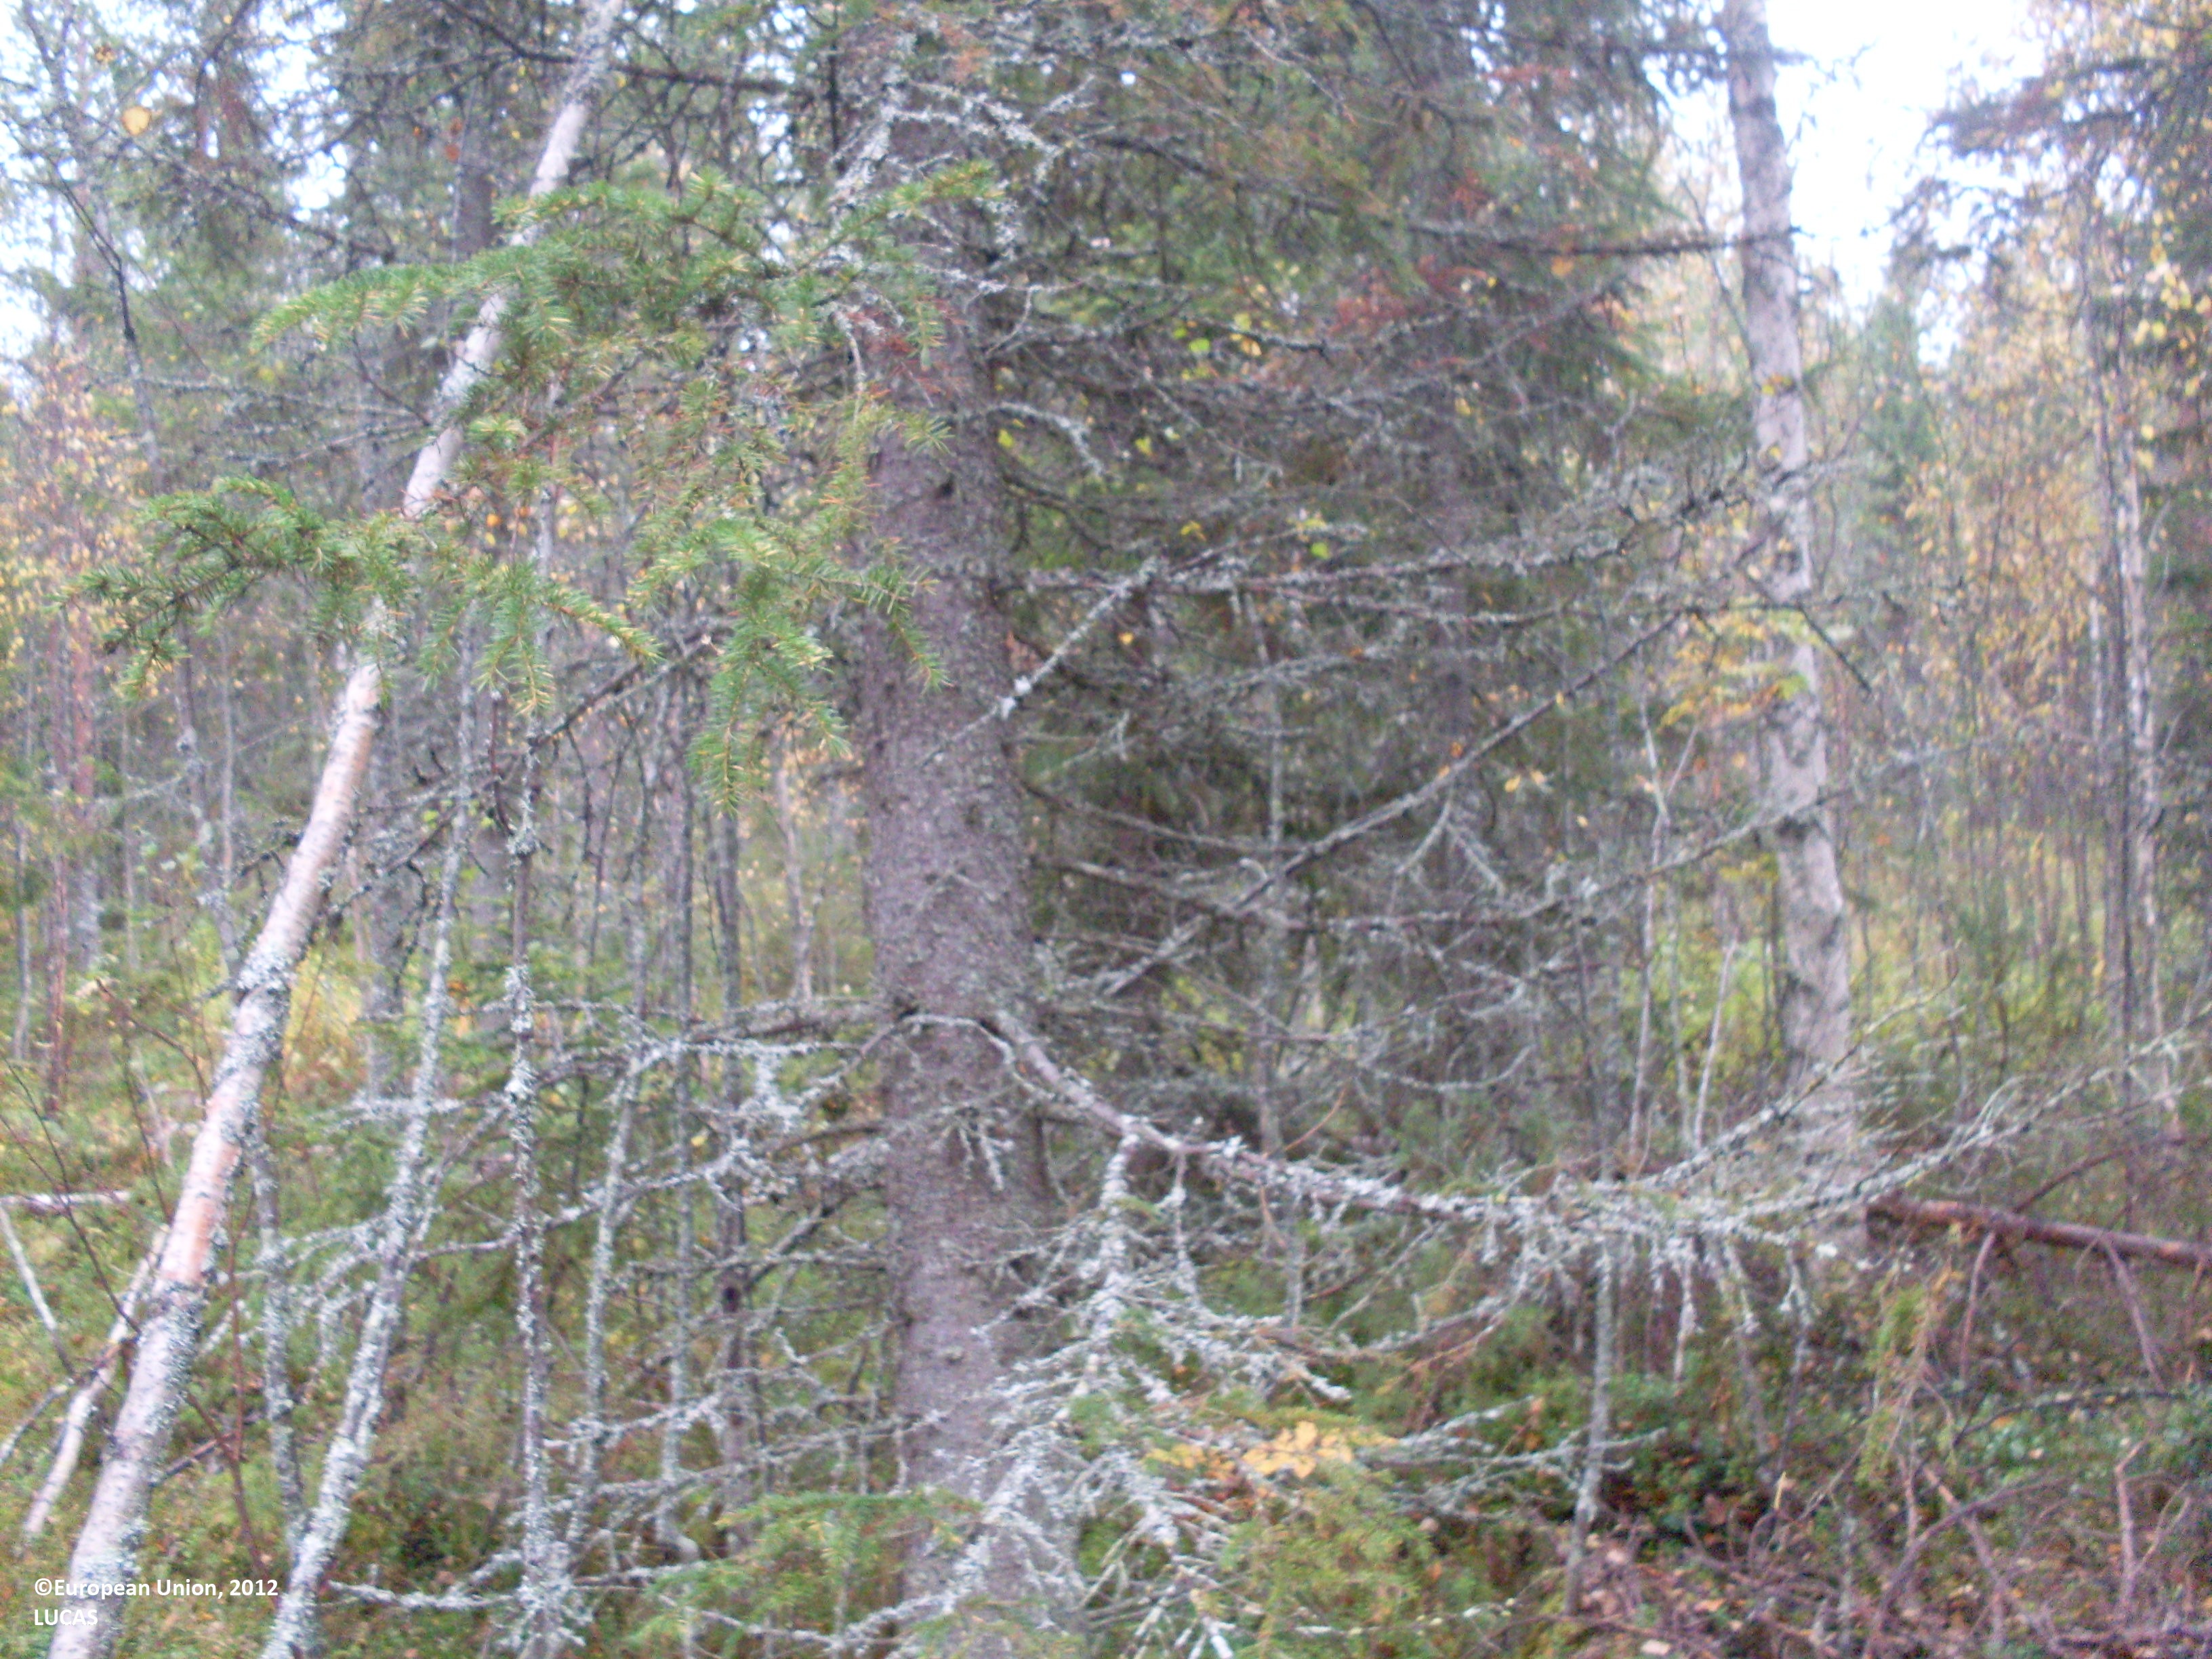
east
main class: Woodland
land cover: Spruce dominated mixed woodland
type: boreal forest
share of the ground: 50 - 75 %
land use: Forestry
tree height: > 5 m
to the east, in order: Spruce dominated mixed woodland
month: September
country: FI
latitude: 64.3080
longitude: 29.3757
